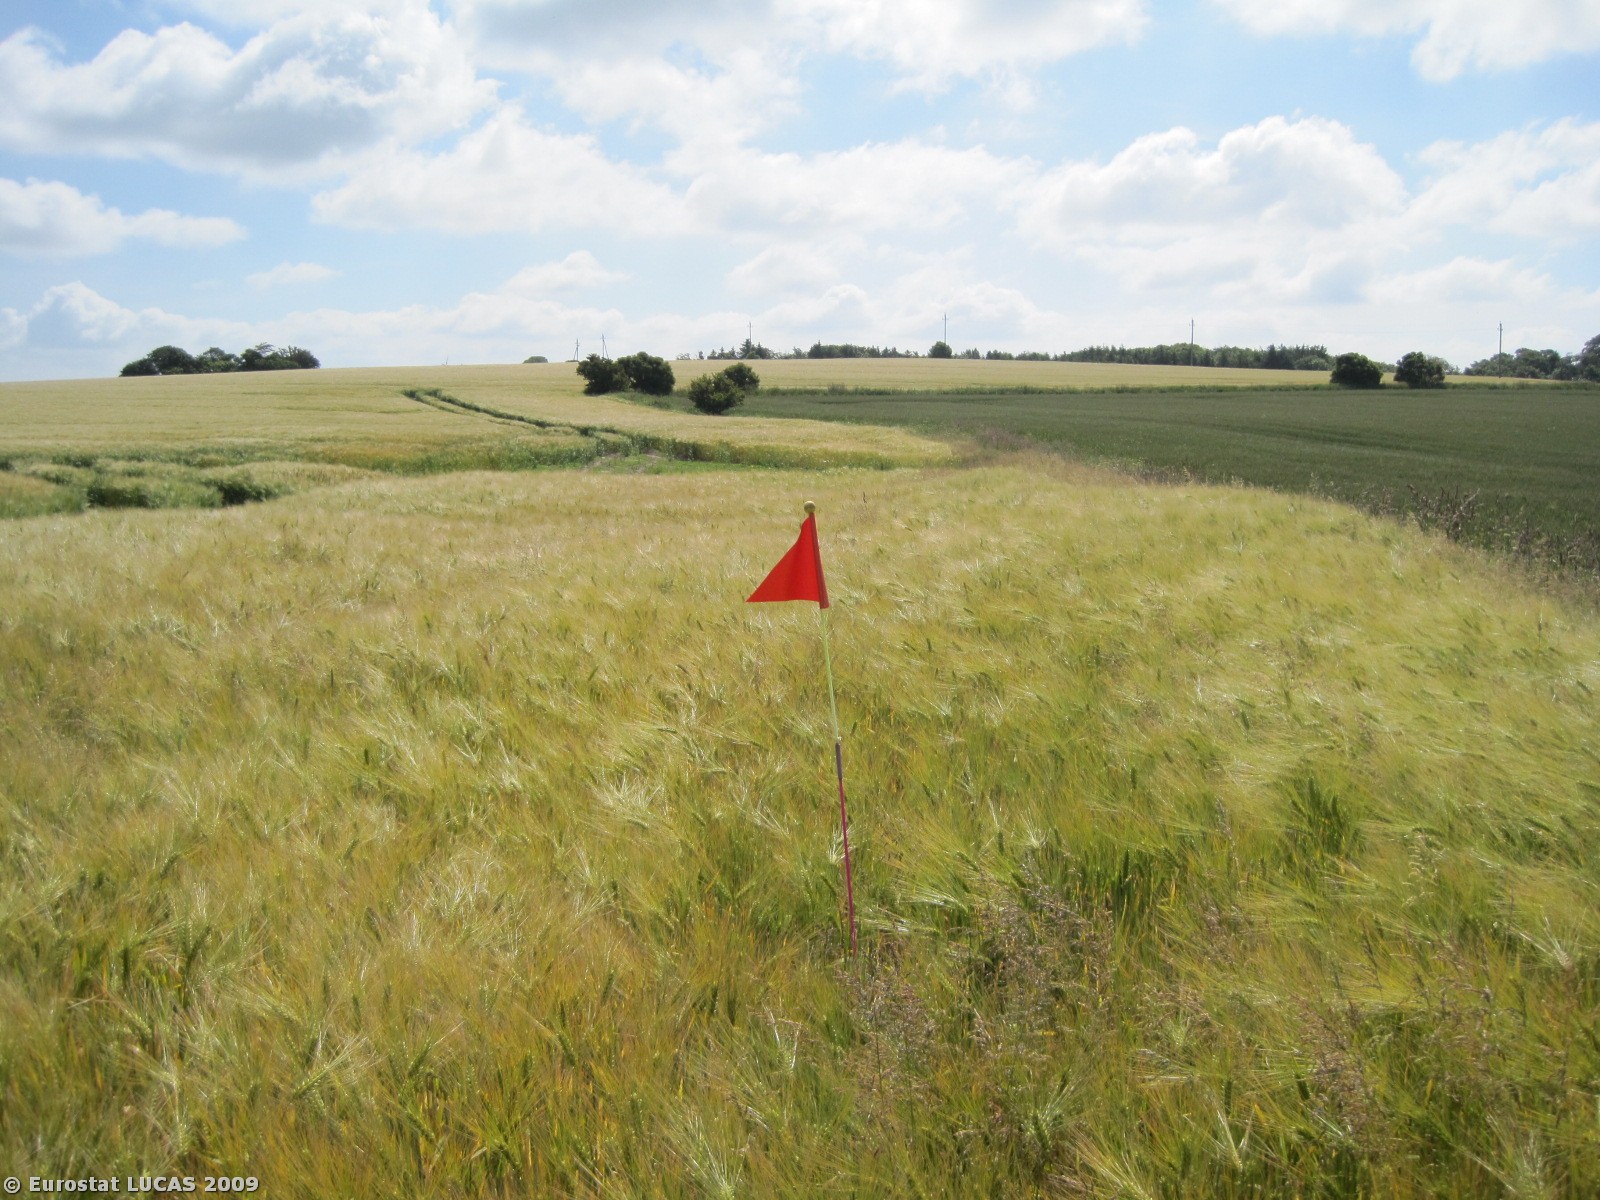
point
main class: Cropland
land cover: Barley
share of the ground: > 75 %
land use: Agriculture (excluding fallow land and kitchen gardens)
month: June
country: DK
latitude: 56.7925
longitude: 8.7084
